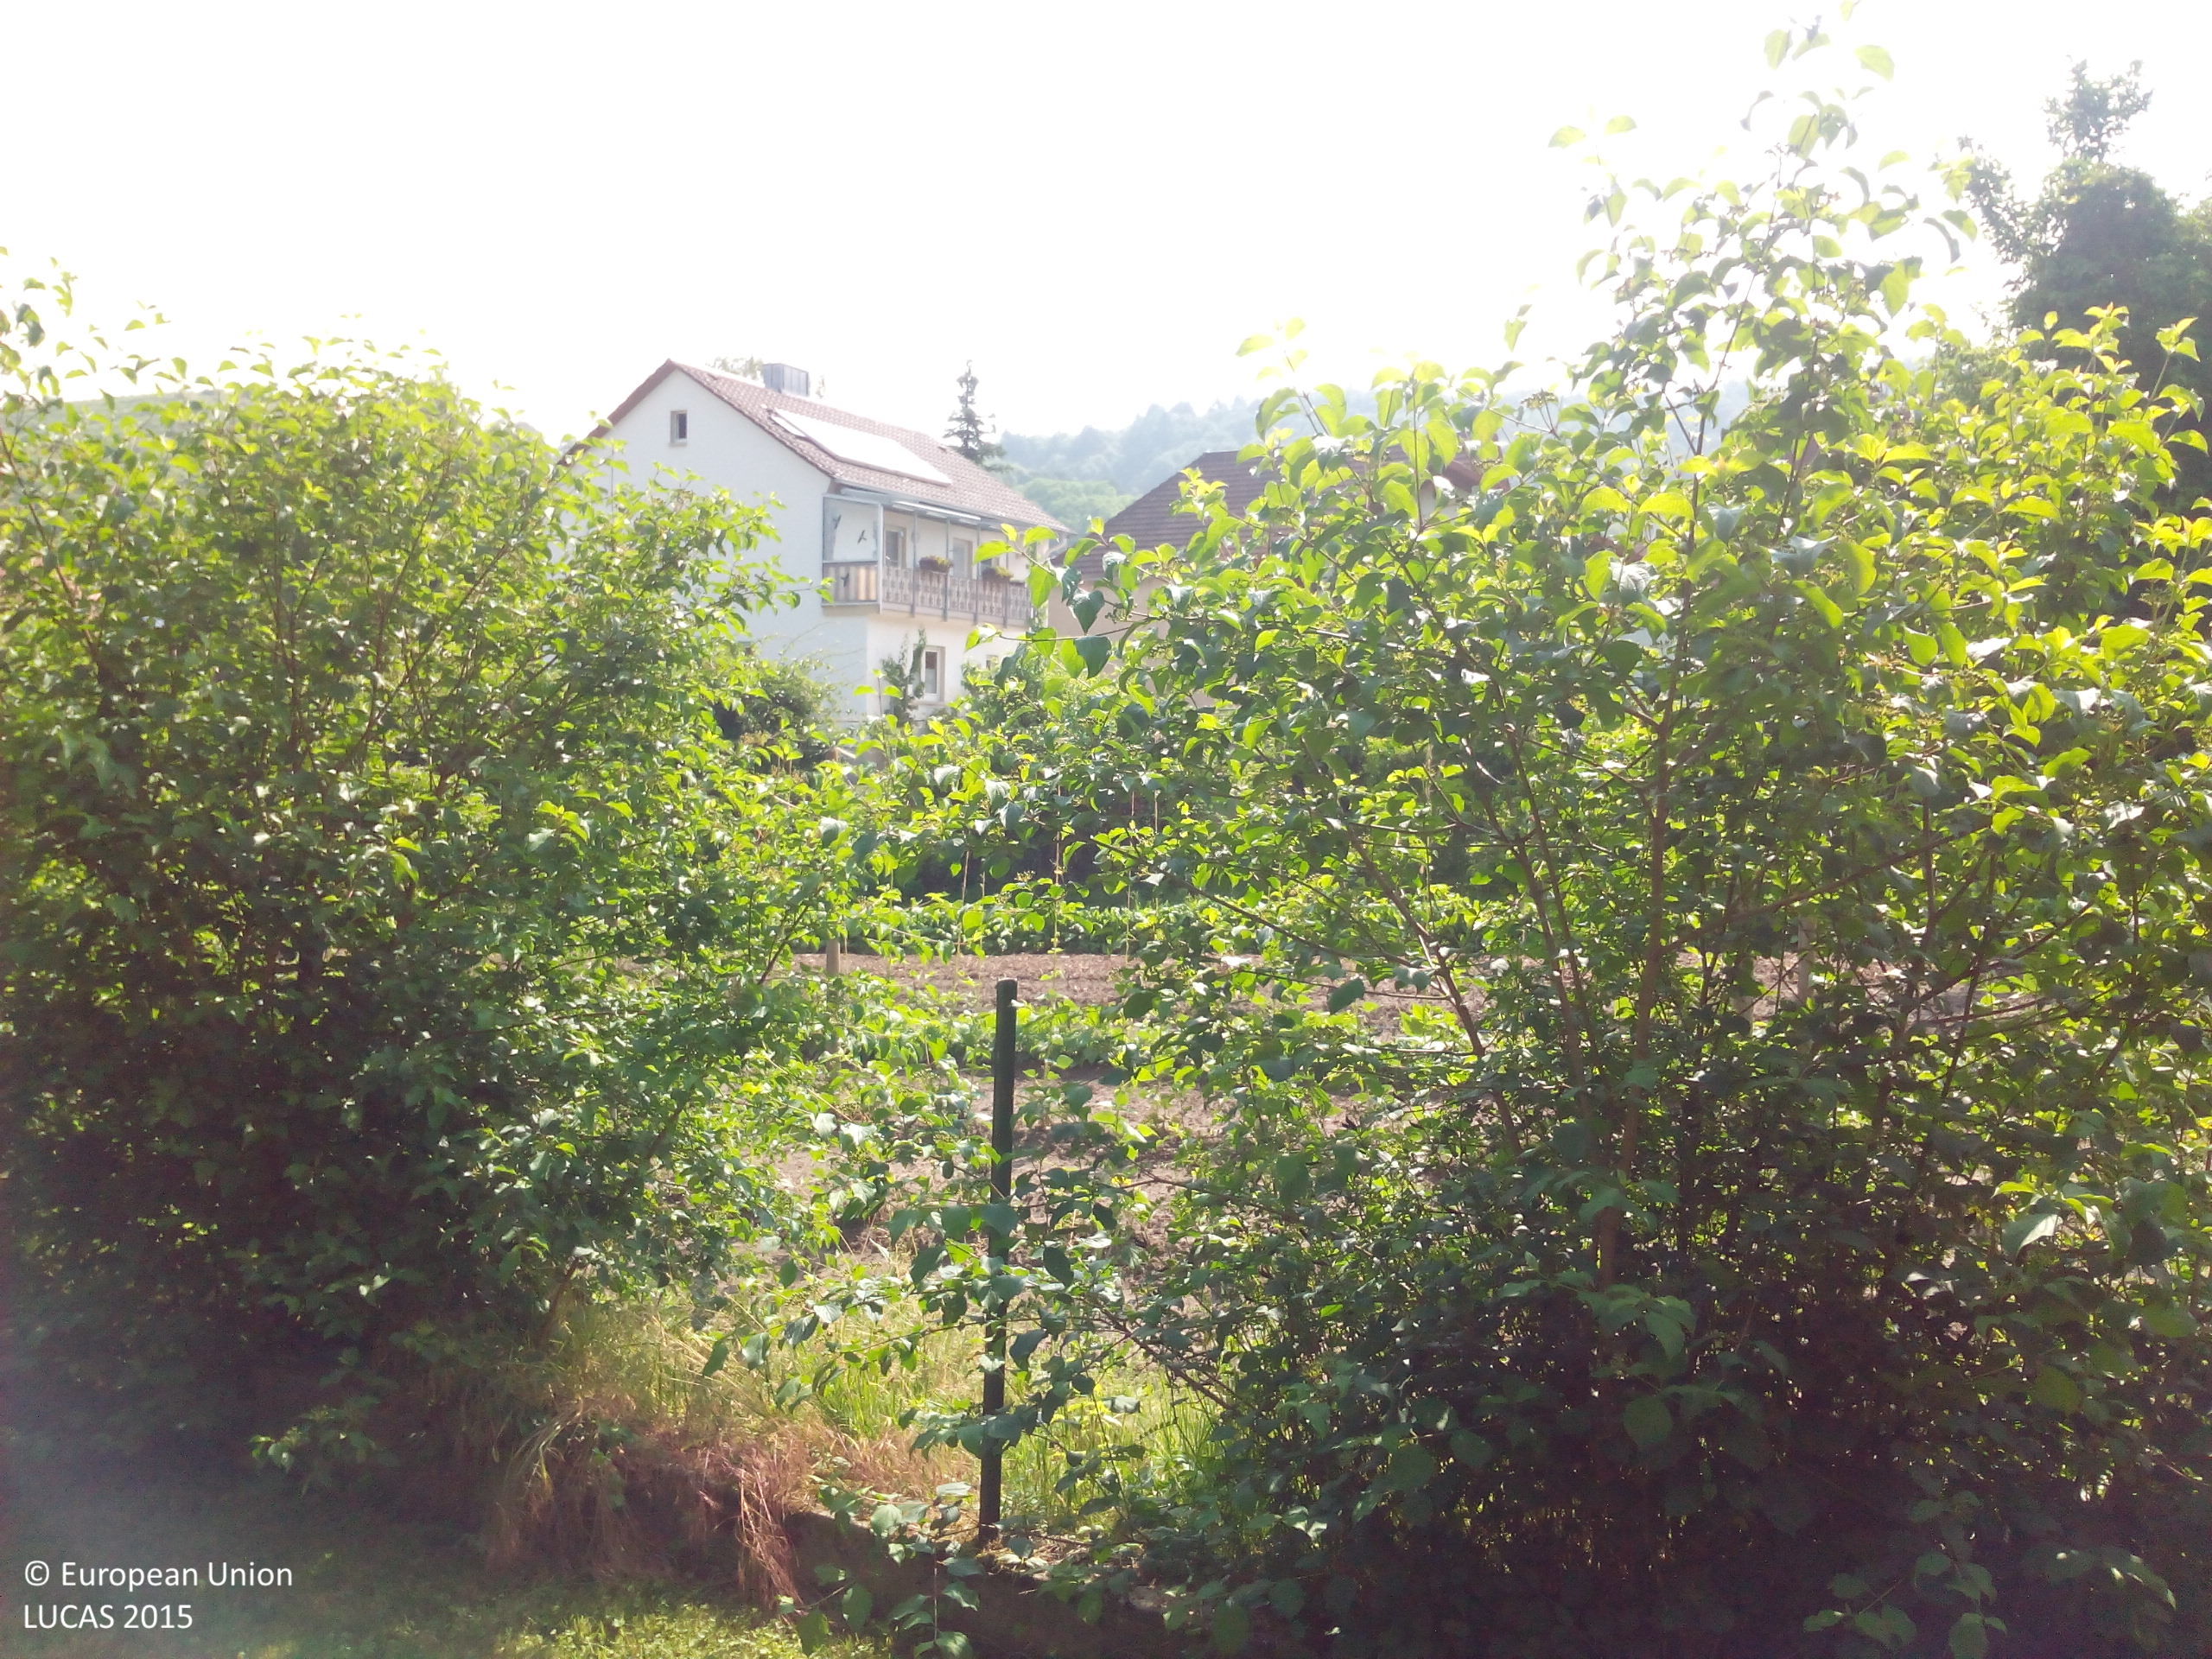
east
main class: Woodland
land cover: Broadleaved woodland
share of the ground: > 75 %
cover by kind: herbaceous plants 65 %, broadleaved forest trees 15 %, shrubs 10 %, consolidated bare surface 10 %
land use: Residential
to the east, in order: Broadleaved woodland; Artificial constructions in urban areas
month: June
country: DE
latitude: 48.1271
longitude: 7.6768
